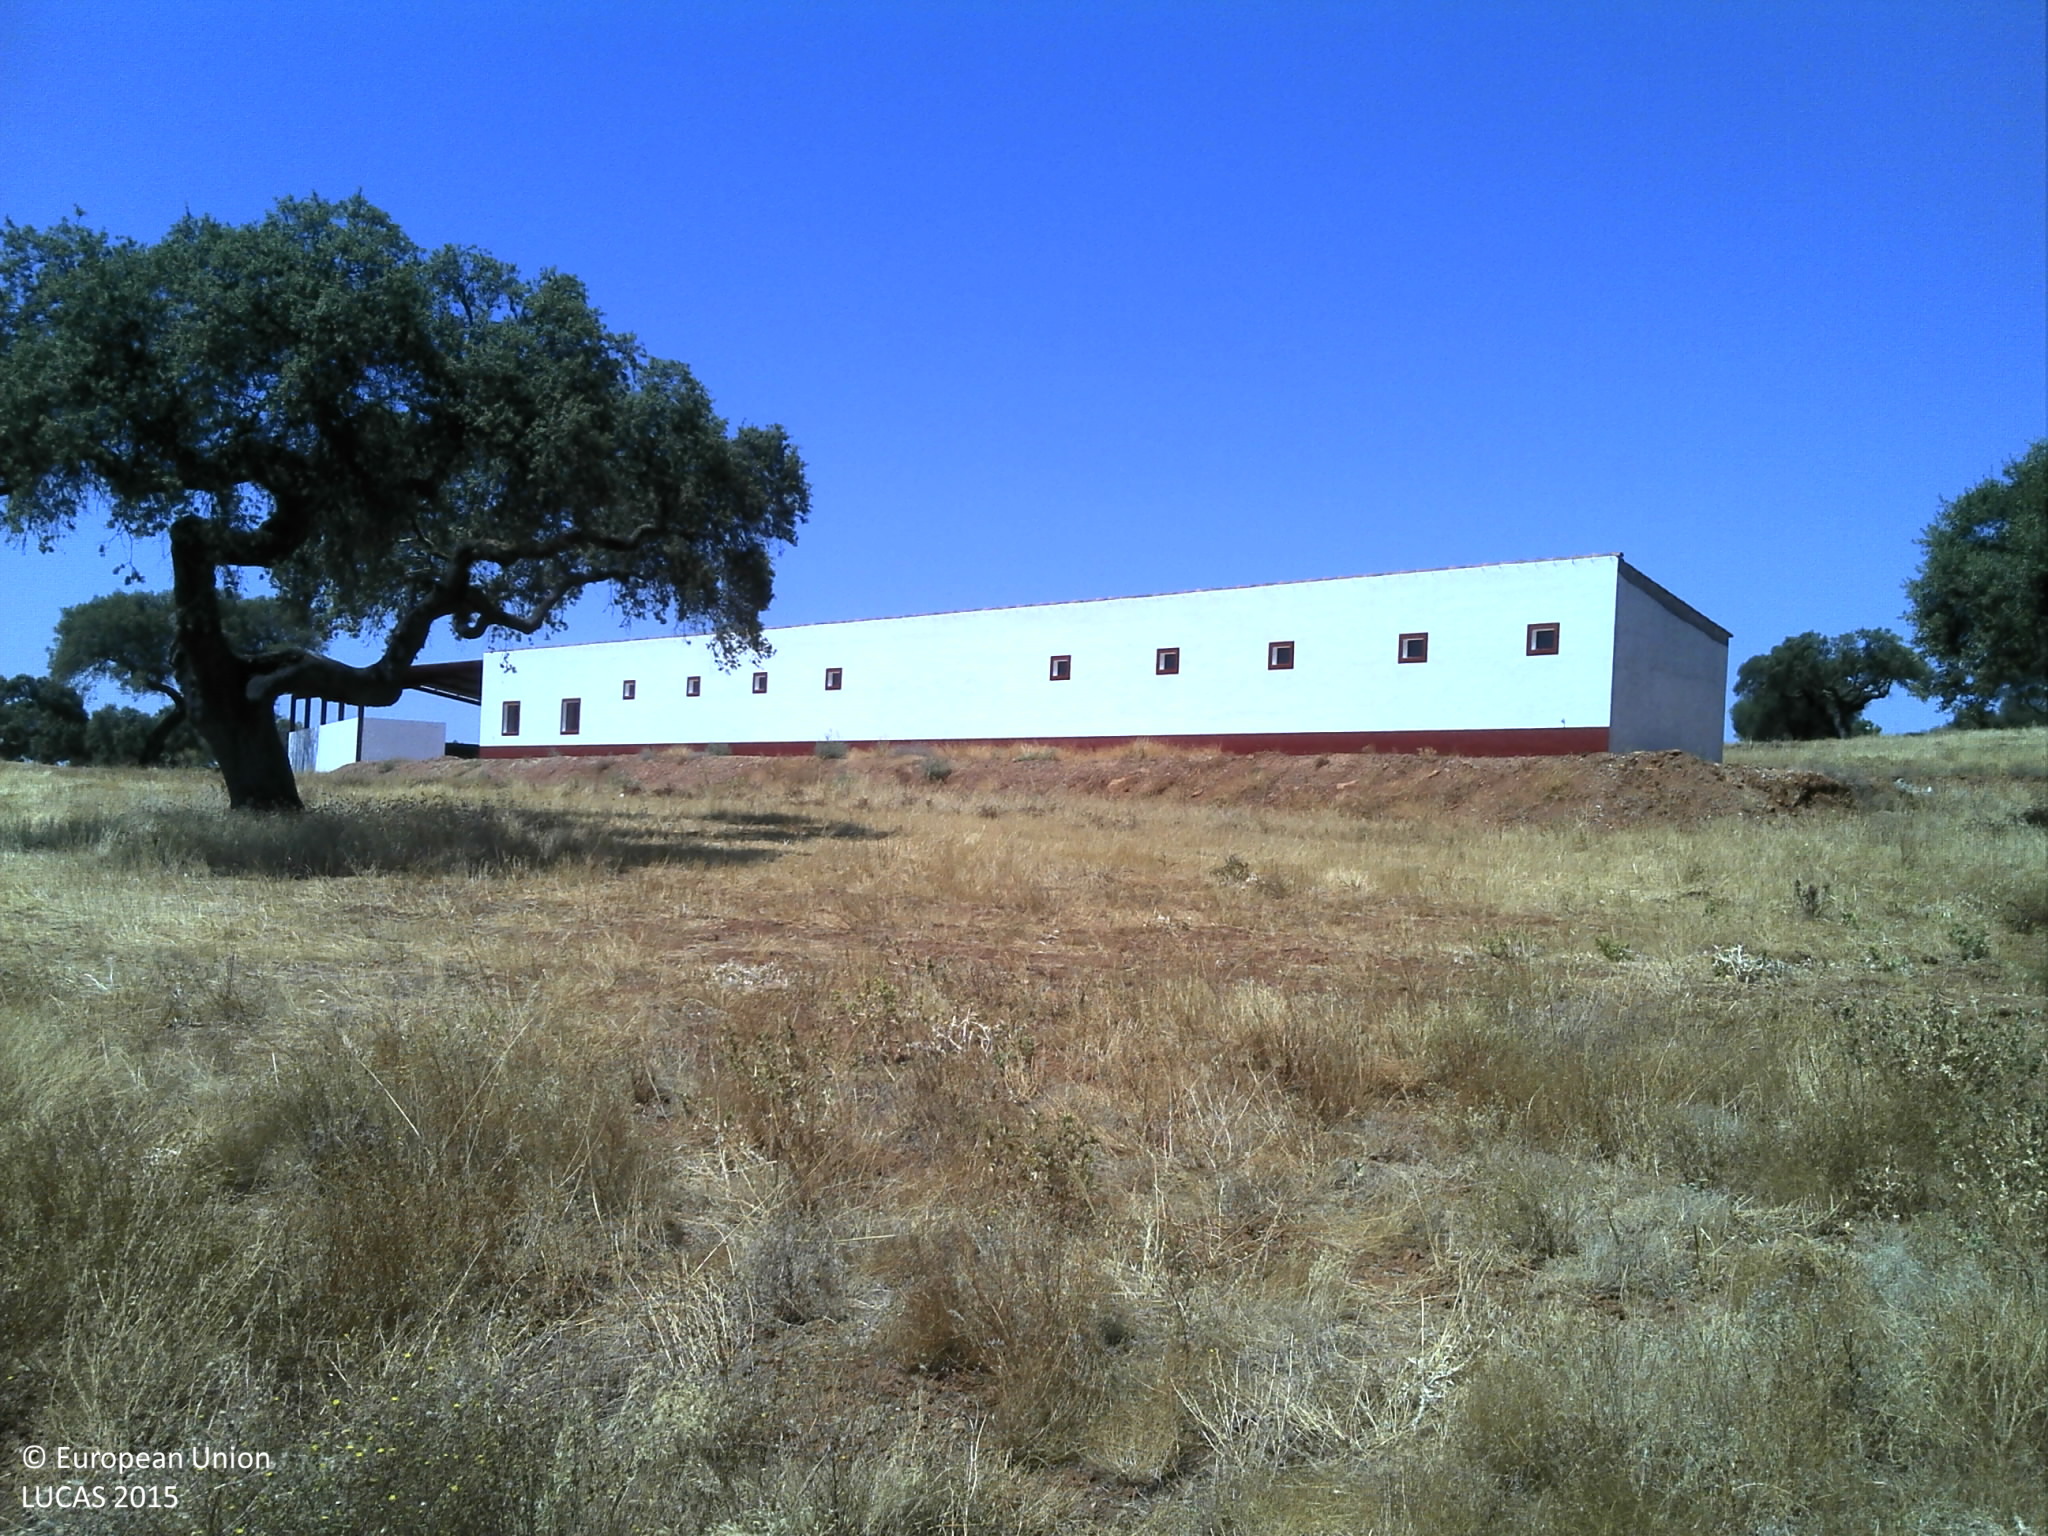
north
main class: Grassland
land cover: Grassland without tree/shrub cover
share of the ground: 25 - 50 %
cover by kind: unconsolidated bare surface 60 %, herbaceous plants 40 %
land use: Agriculture (excluding fallow land and kitchen gardens)
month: July
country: PT
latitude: 38.5480
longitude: -7.3167
